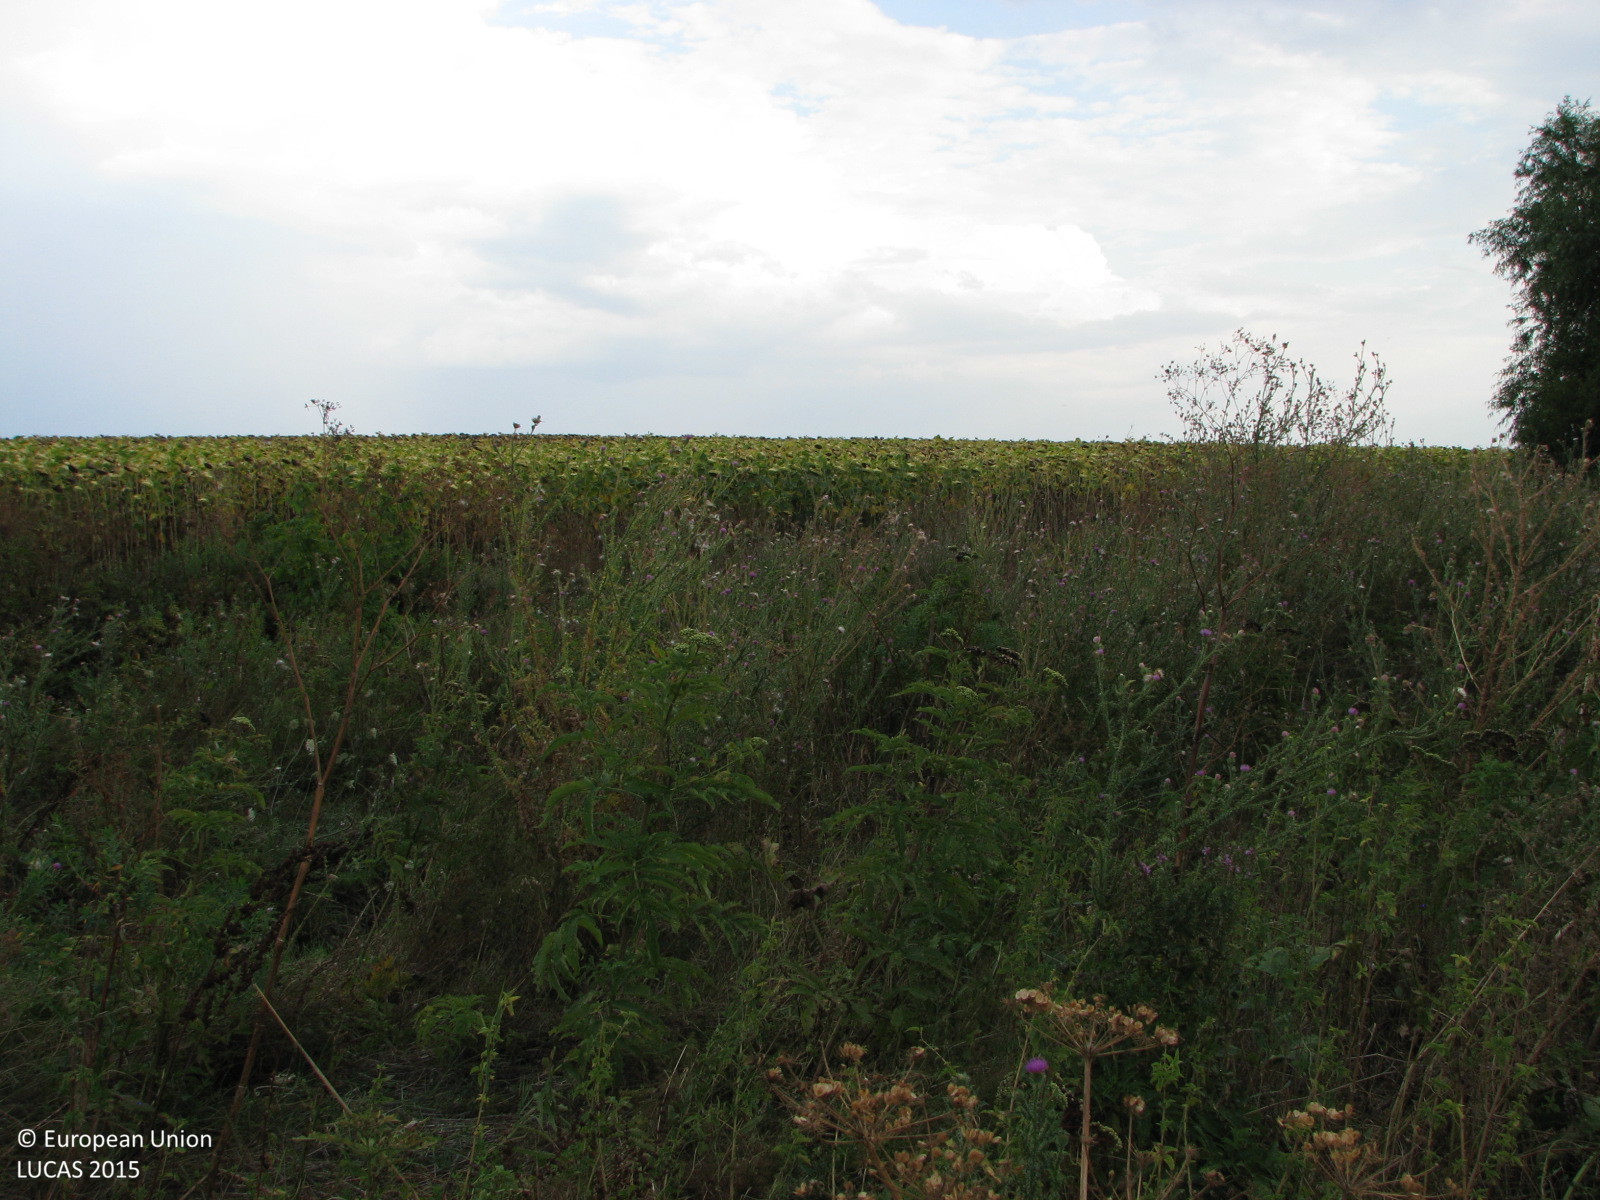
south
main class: Grassland
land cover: Grassland with sparse tree/shrub cover
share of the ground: > 75 %
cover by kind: herbaceous plants 90 %, coniferous forest trees 5 %, shrubs 5 %
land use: Agriculture (excluding fallow land and kitchen gardens)
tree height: > 5 m
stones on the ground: < 10 %
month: August
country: BG
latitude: 42.4378
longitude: 26.5651
